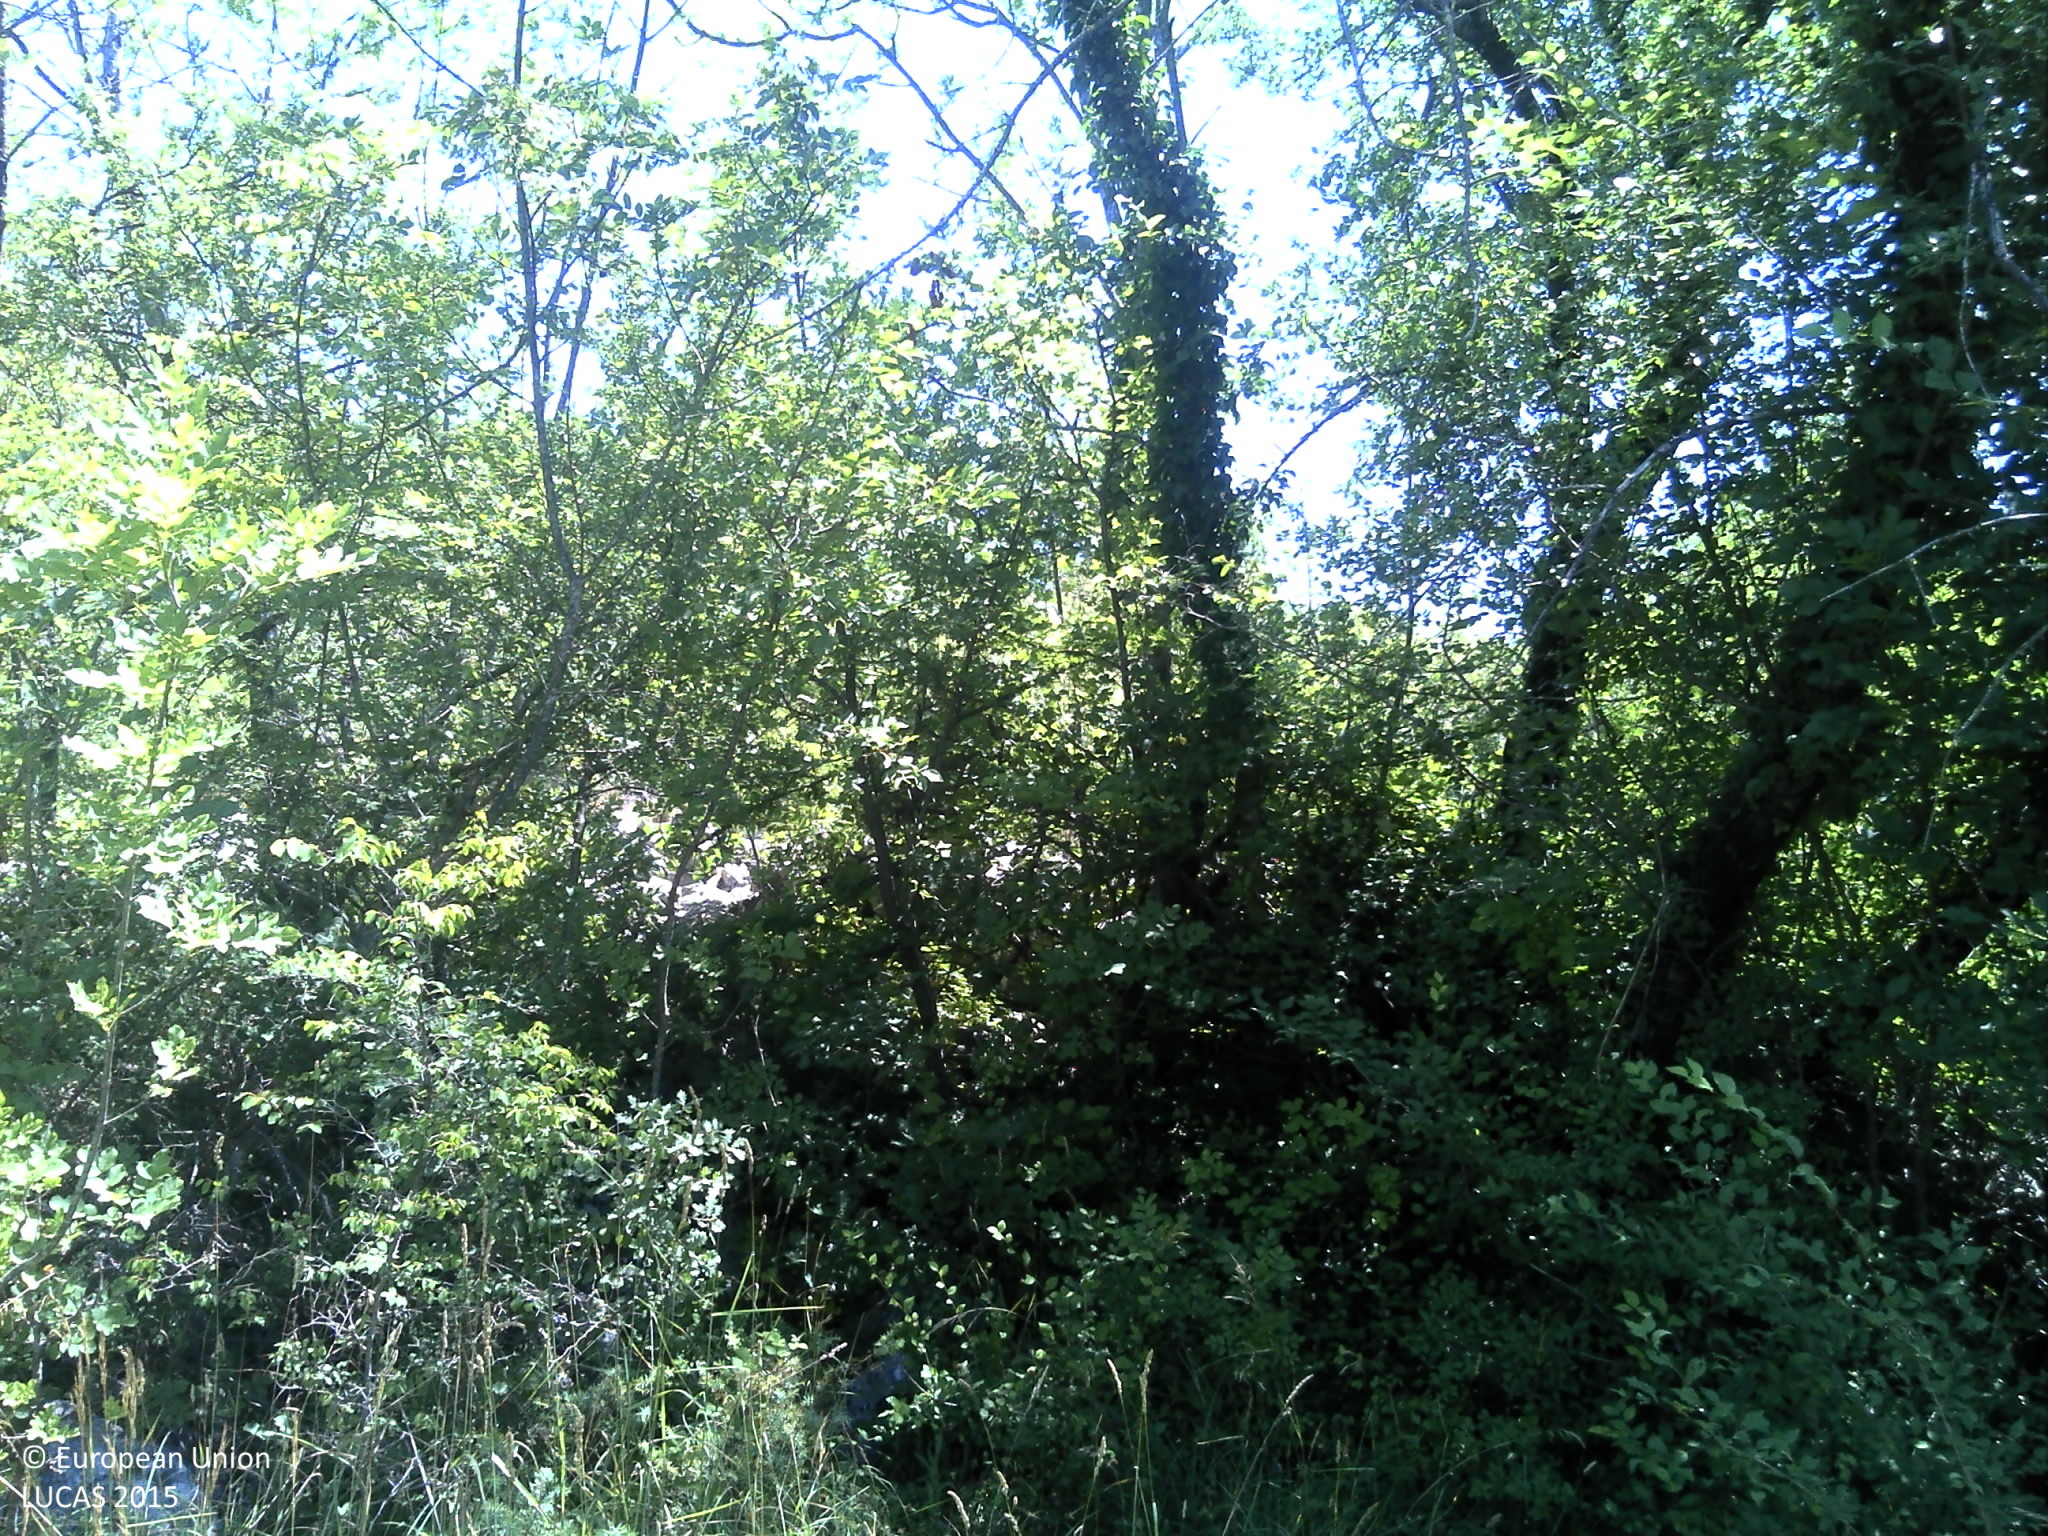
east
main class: Grassland
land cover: Grassland with sparse tree/shrub cover
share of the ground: > 75 %
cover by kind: herbaceous plants 80 %, shrubs 10 %, broadleaved forest trees 5 %, unconsolidated bare surface 5 %
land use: Agriculture (excluding fallow land and kitchen gardens)
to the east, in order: Grassland with sparse tree/shrub cover; Broadleaved woodland; Grassland with sparse tree/shrub cover; Dry stone walls; Shrubland without tree cover; Grassland with sparse tree/shrub cover; Shrubland with sparse tree cover; Dry stone walls; Shrubland with sparse tree cover; Grassland with sparse tree/shrub cover; Shrubland with sparse tree cover
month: June
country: HR
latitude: 43.6338
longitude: 16.5980
